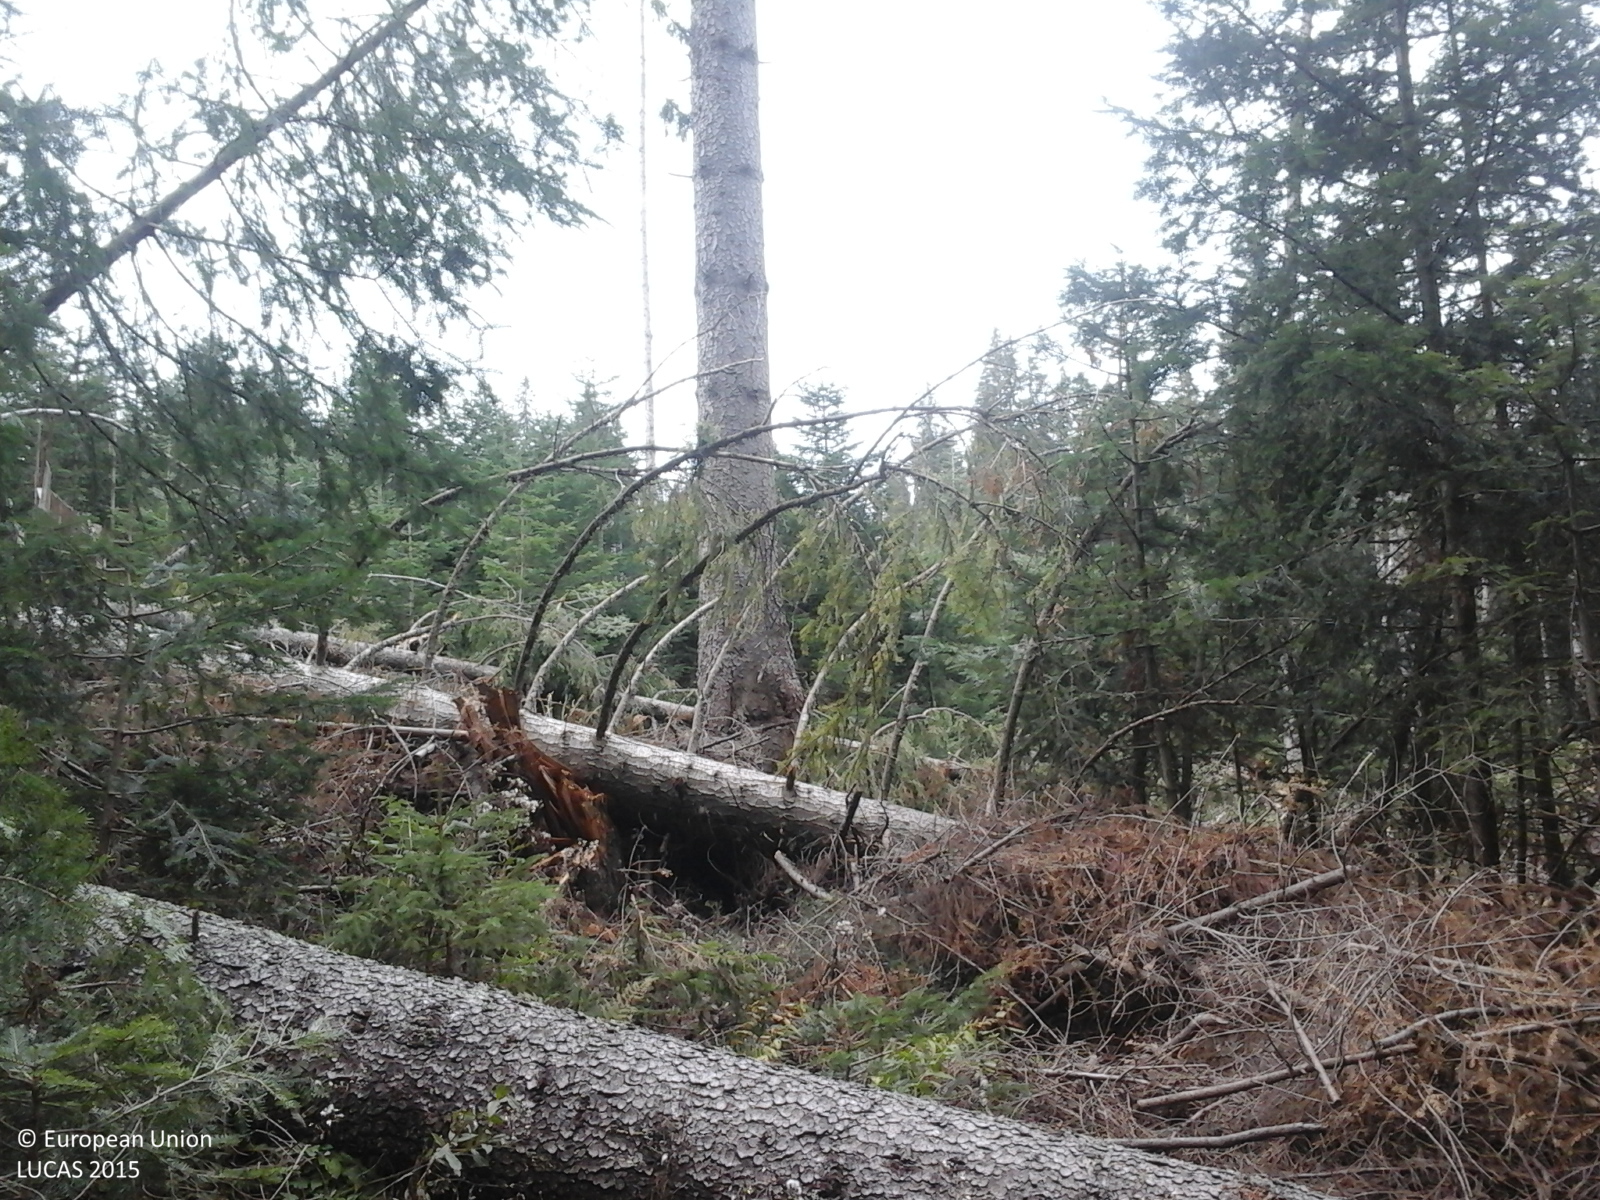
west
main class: Woodland
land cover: Spruce dominated coniferous woodland
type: alpine coniferous forest
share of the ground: > 75 %
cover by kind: coniferous forest trees 100 %
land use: Forestry
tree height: > 5 m
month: October
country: RO
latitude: 46.6190
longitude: 25.5329
